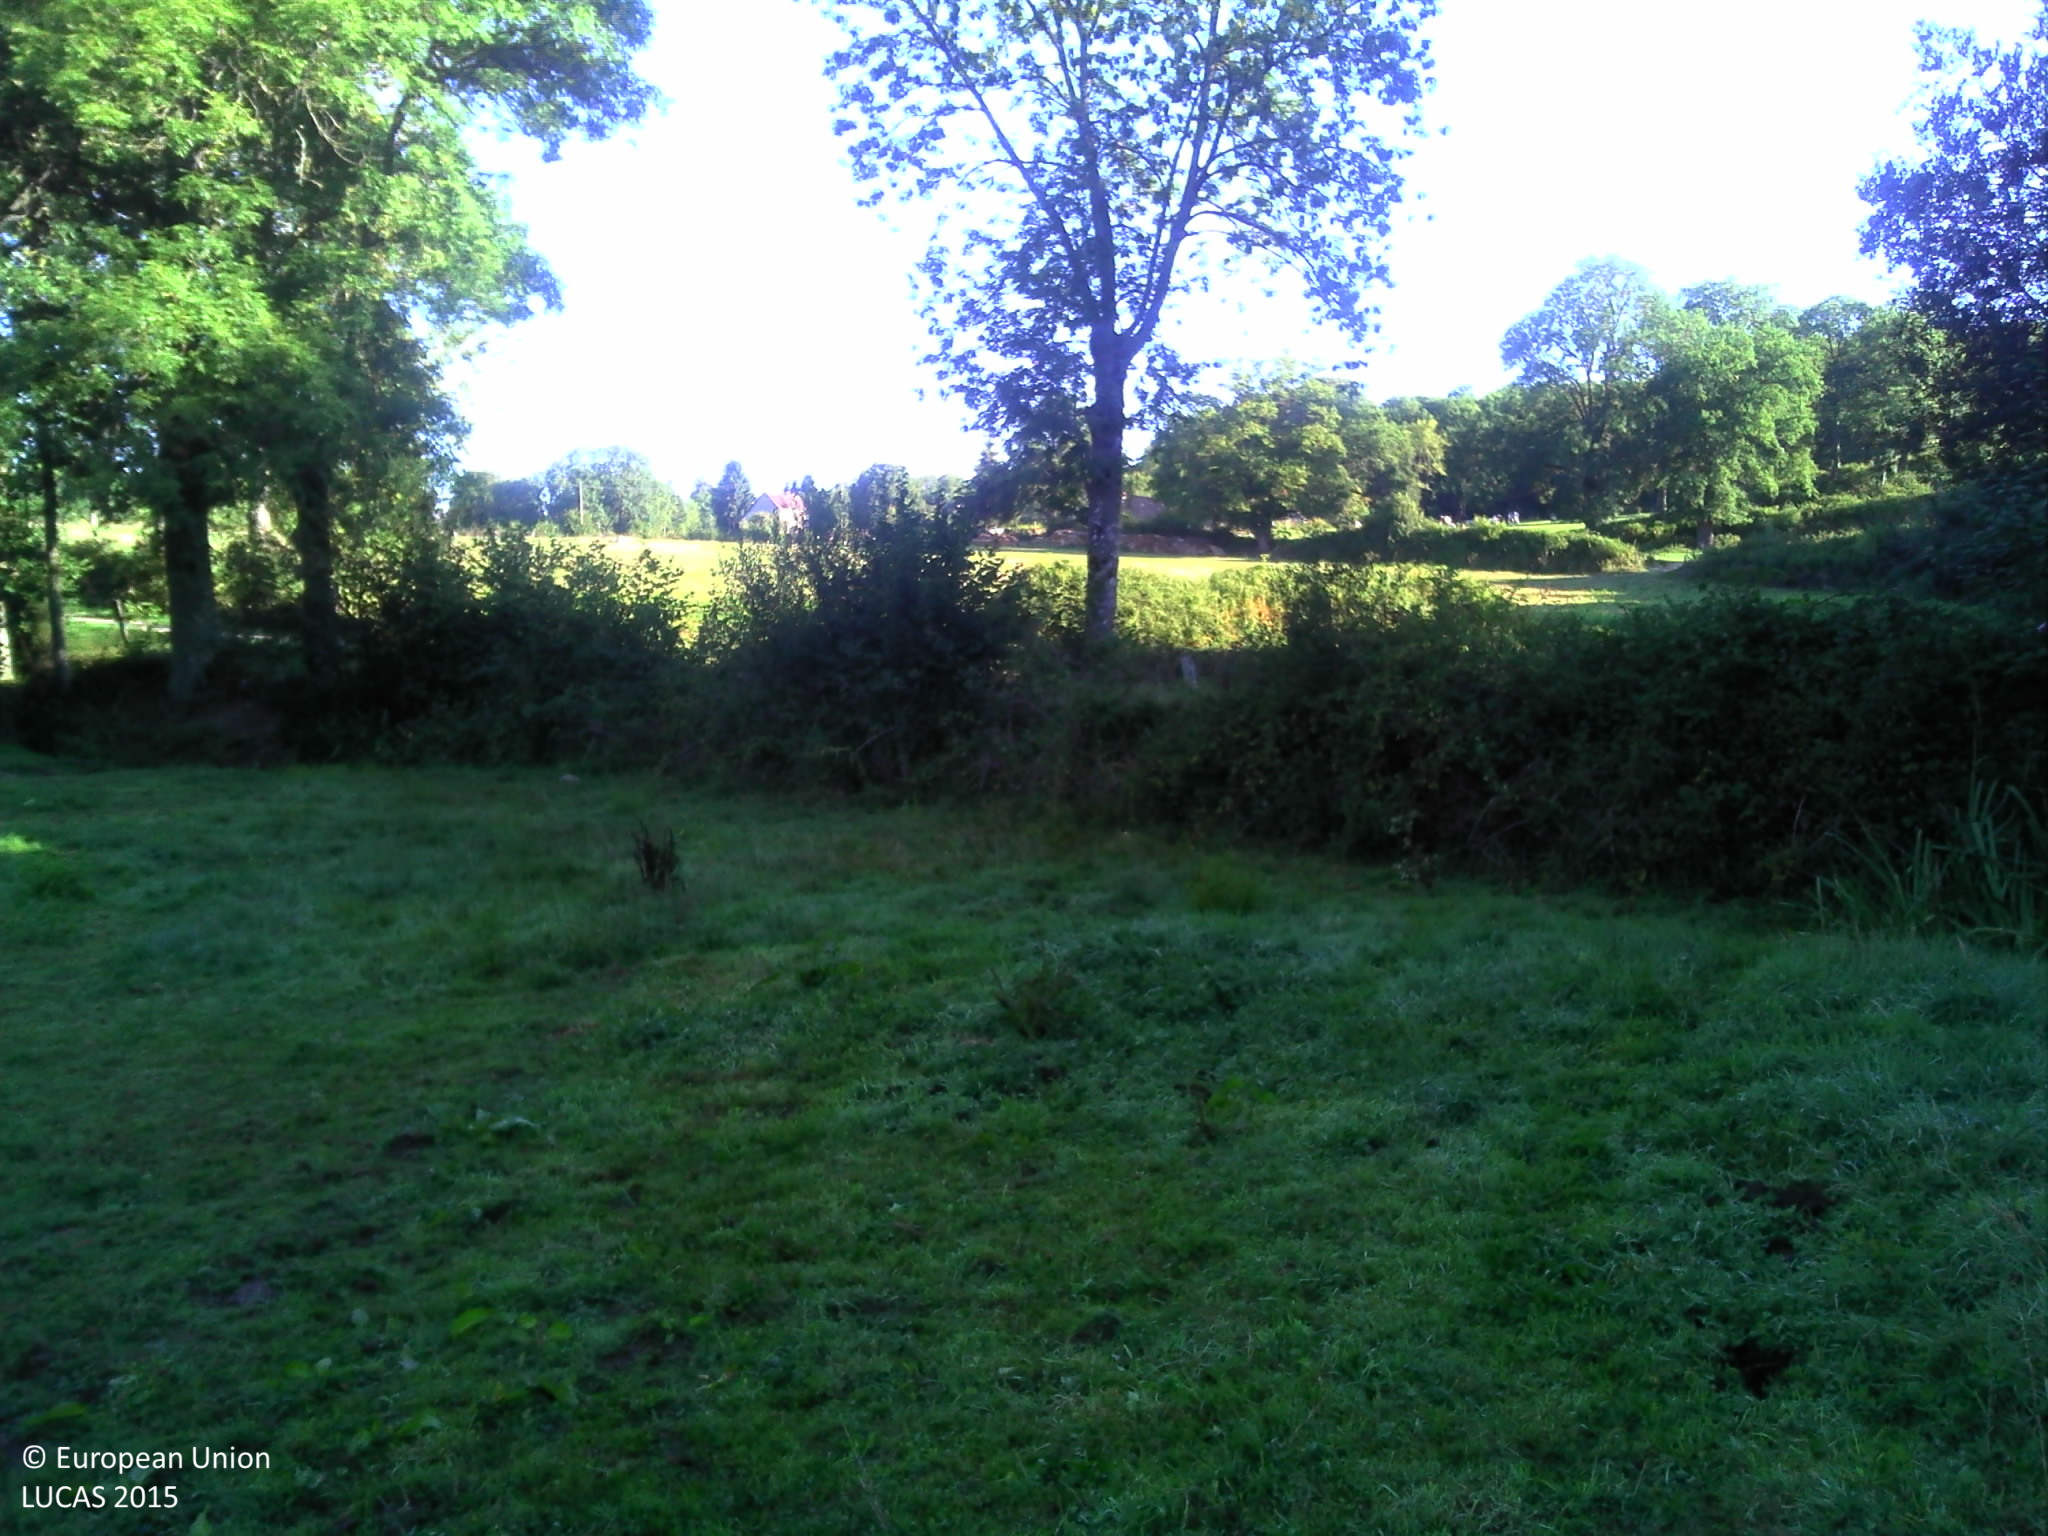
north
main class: Grassland
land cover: Grassland without tree/shrub cover
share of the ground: > 75 %
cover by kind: herbaceous plants 95 %, shrubs 5 %
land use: Agriculture (excluding fallow land and kitchen gardens)
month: August
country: FR
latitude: 45.8426
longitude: 2.3612
